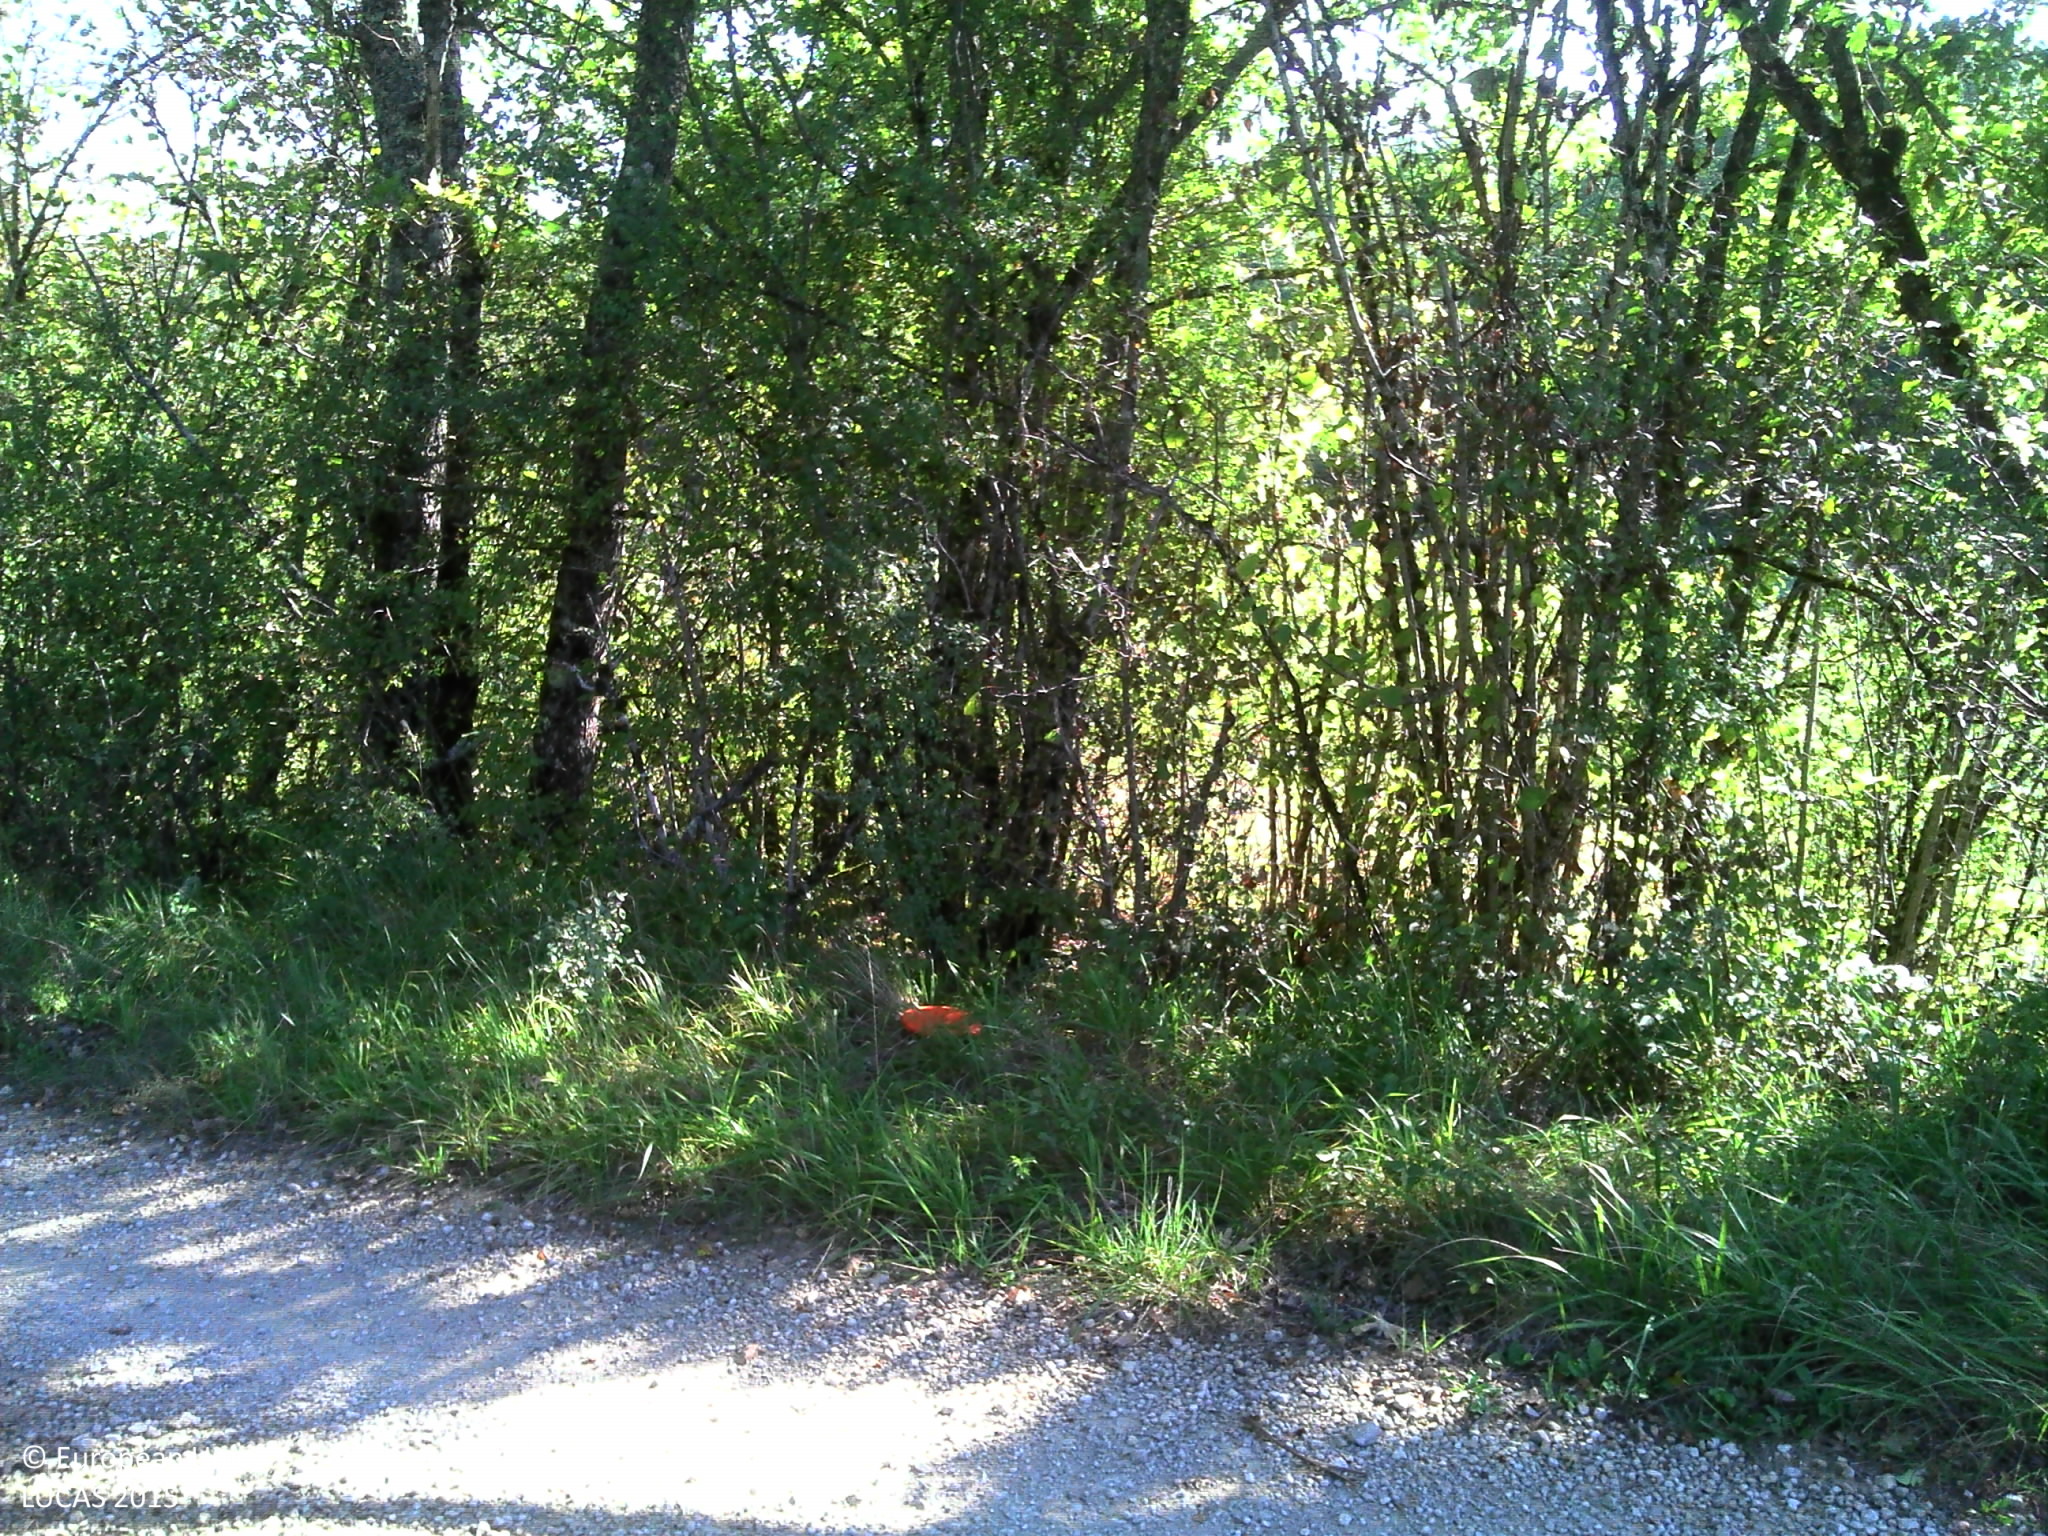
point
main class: Woodland
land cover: Broadleaved woodland
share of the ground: > 75 %
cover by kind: broadleaved forest trees 90 %, herbaceous plants 5 %, lichens and mosses 5 %
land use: Semi-natural and natural areas not in use
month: September
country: FR
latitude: 47.5721
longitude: 4.3222
